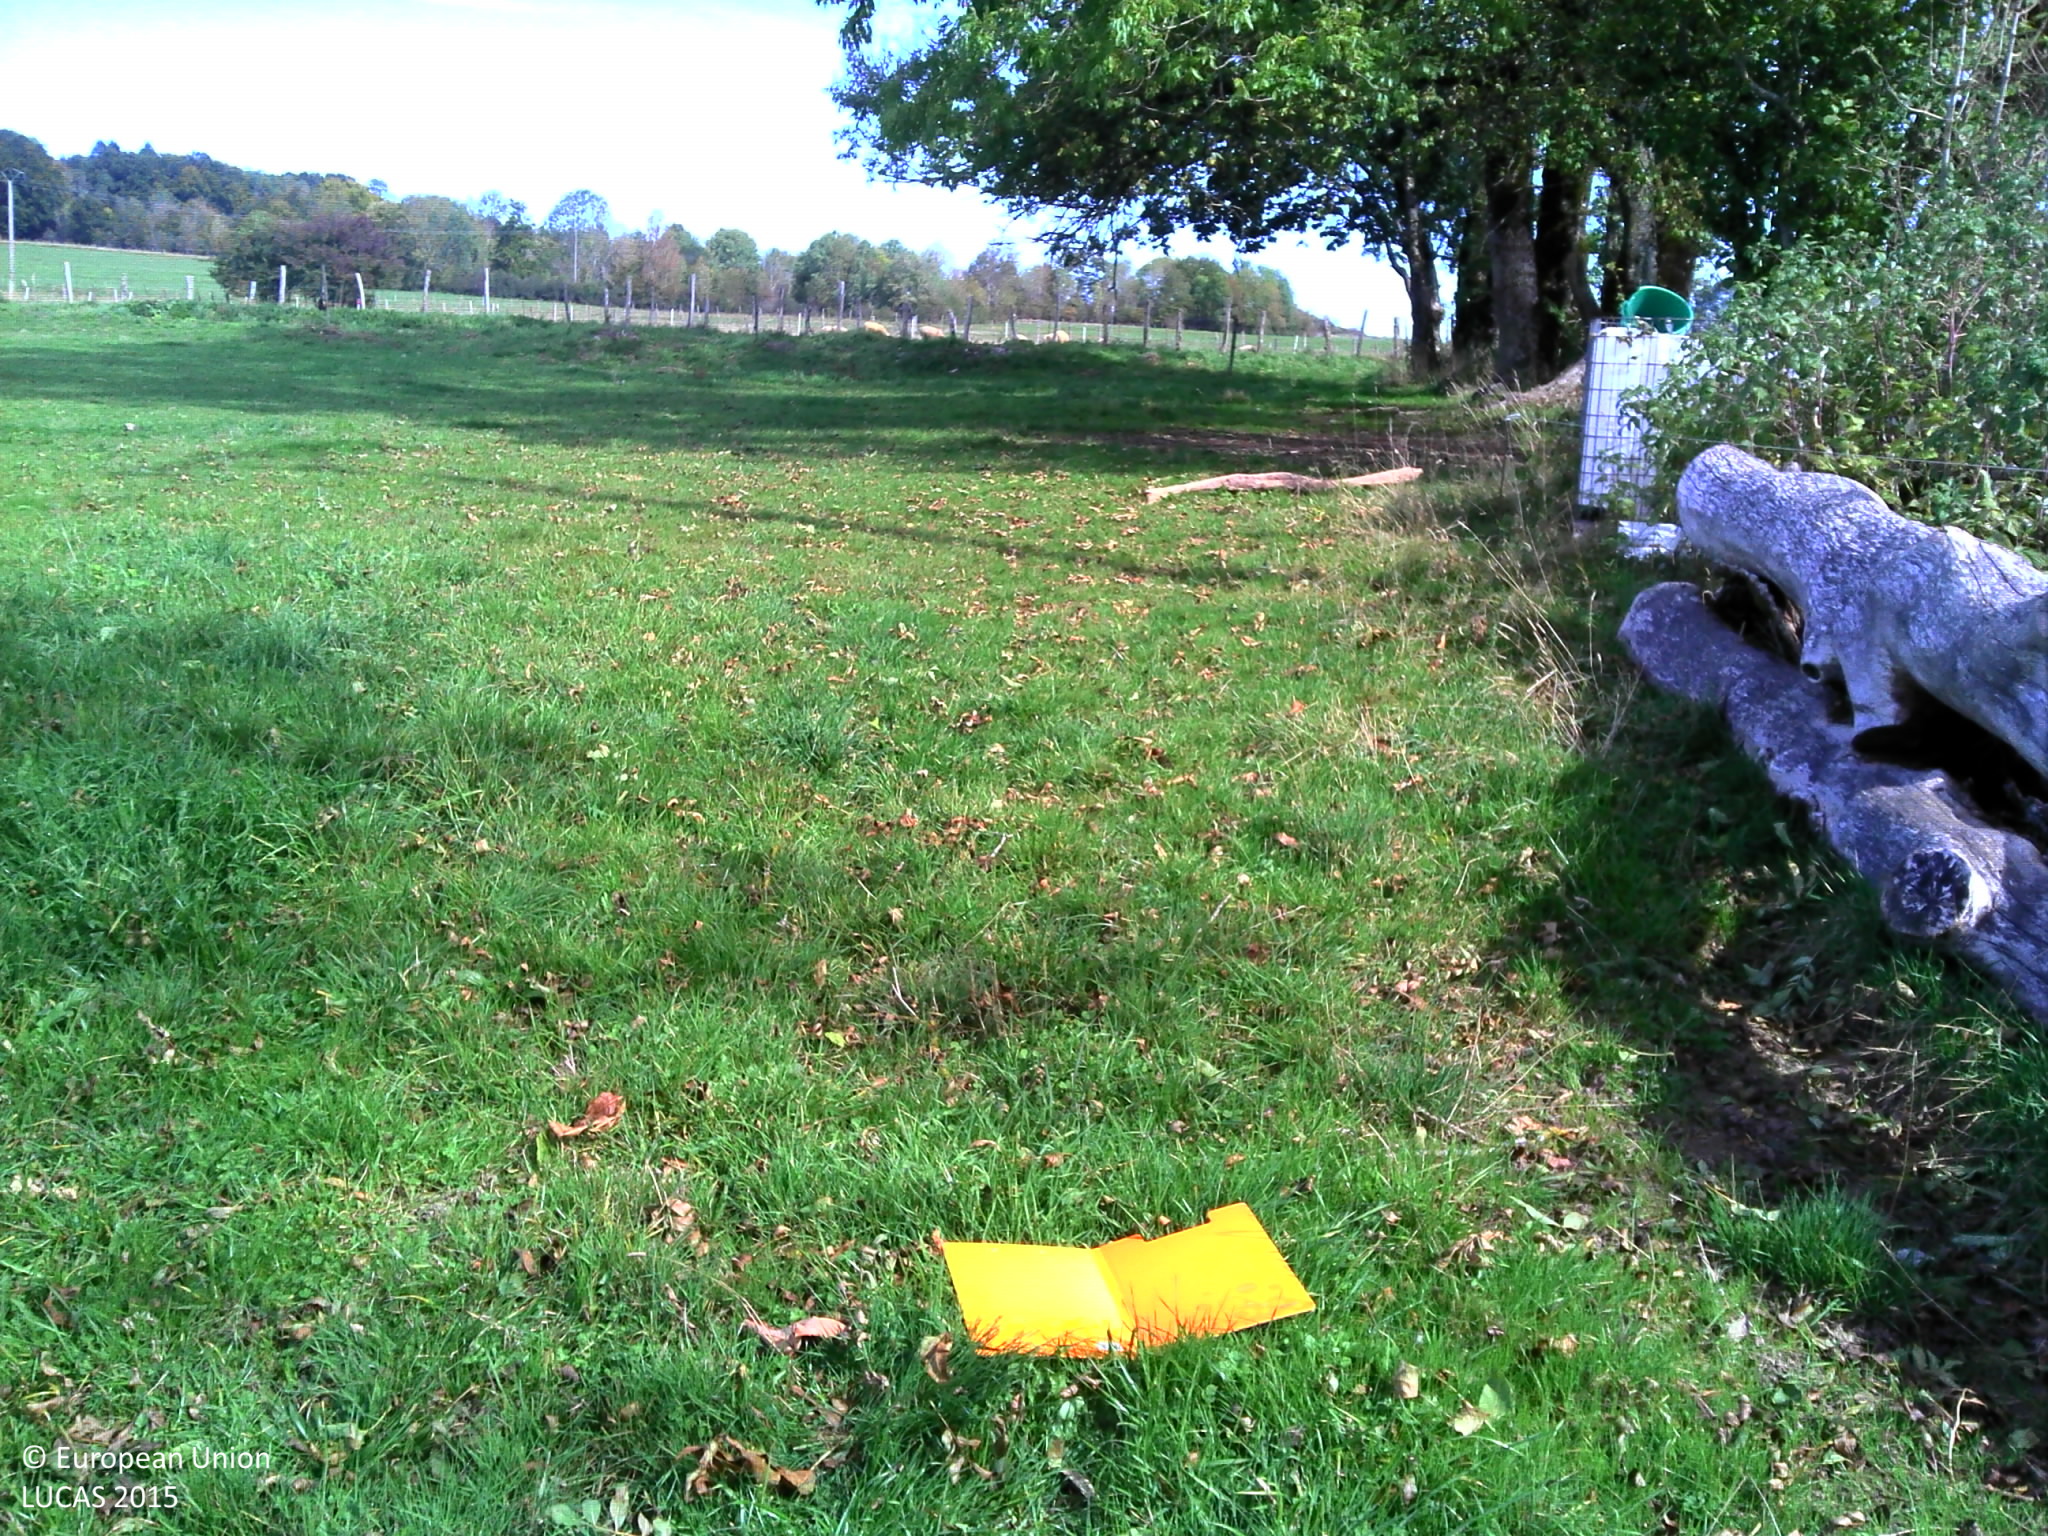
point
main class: Grassland
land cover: Grassland without tree/shrub cover
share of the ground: > 75 %
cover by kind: herbaceous plants 100 %
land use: Agriculture (excluding fallow land and kitchen gardens)
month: October
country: FR
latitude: 46.9564
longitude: 6.3624
